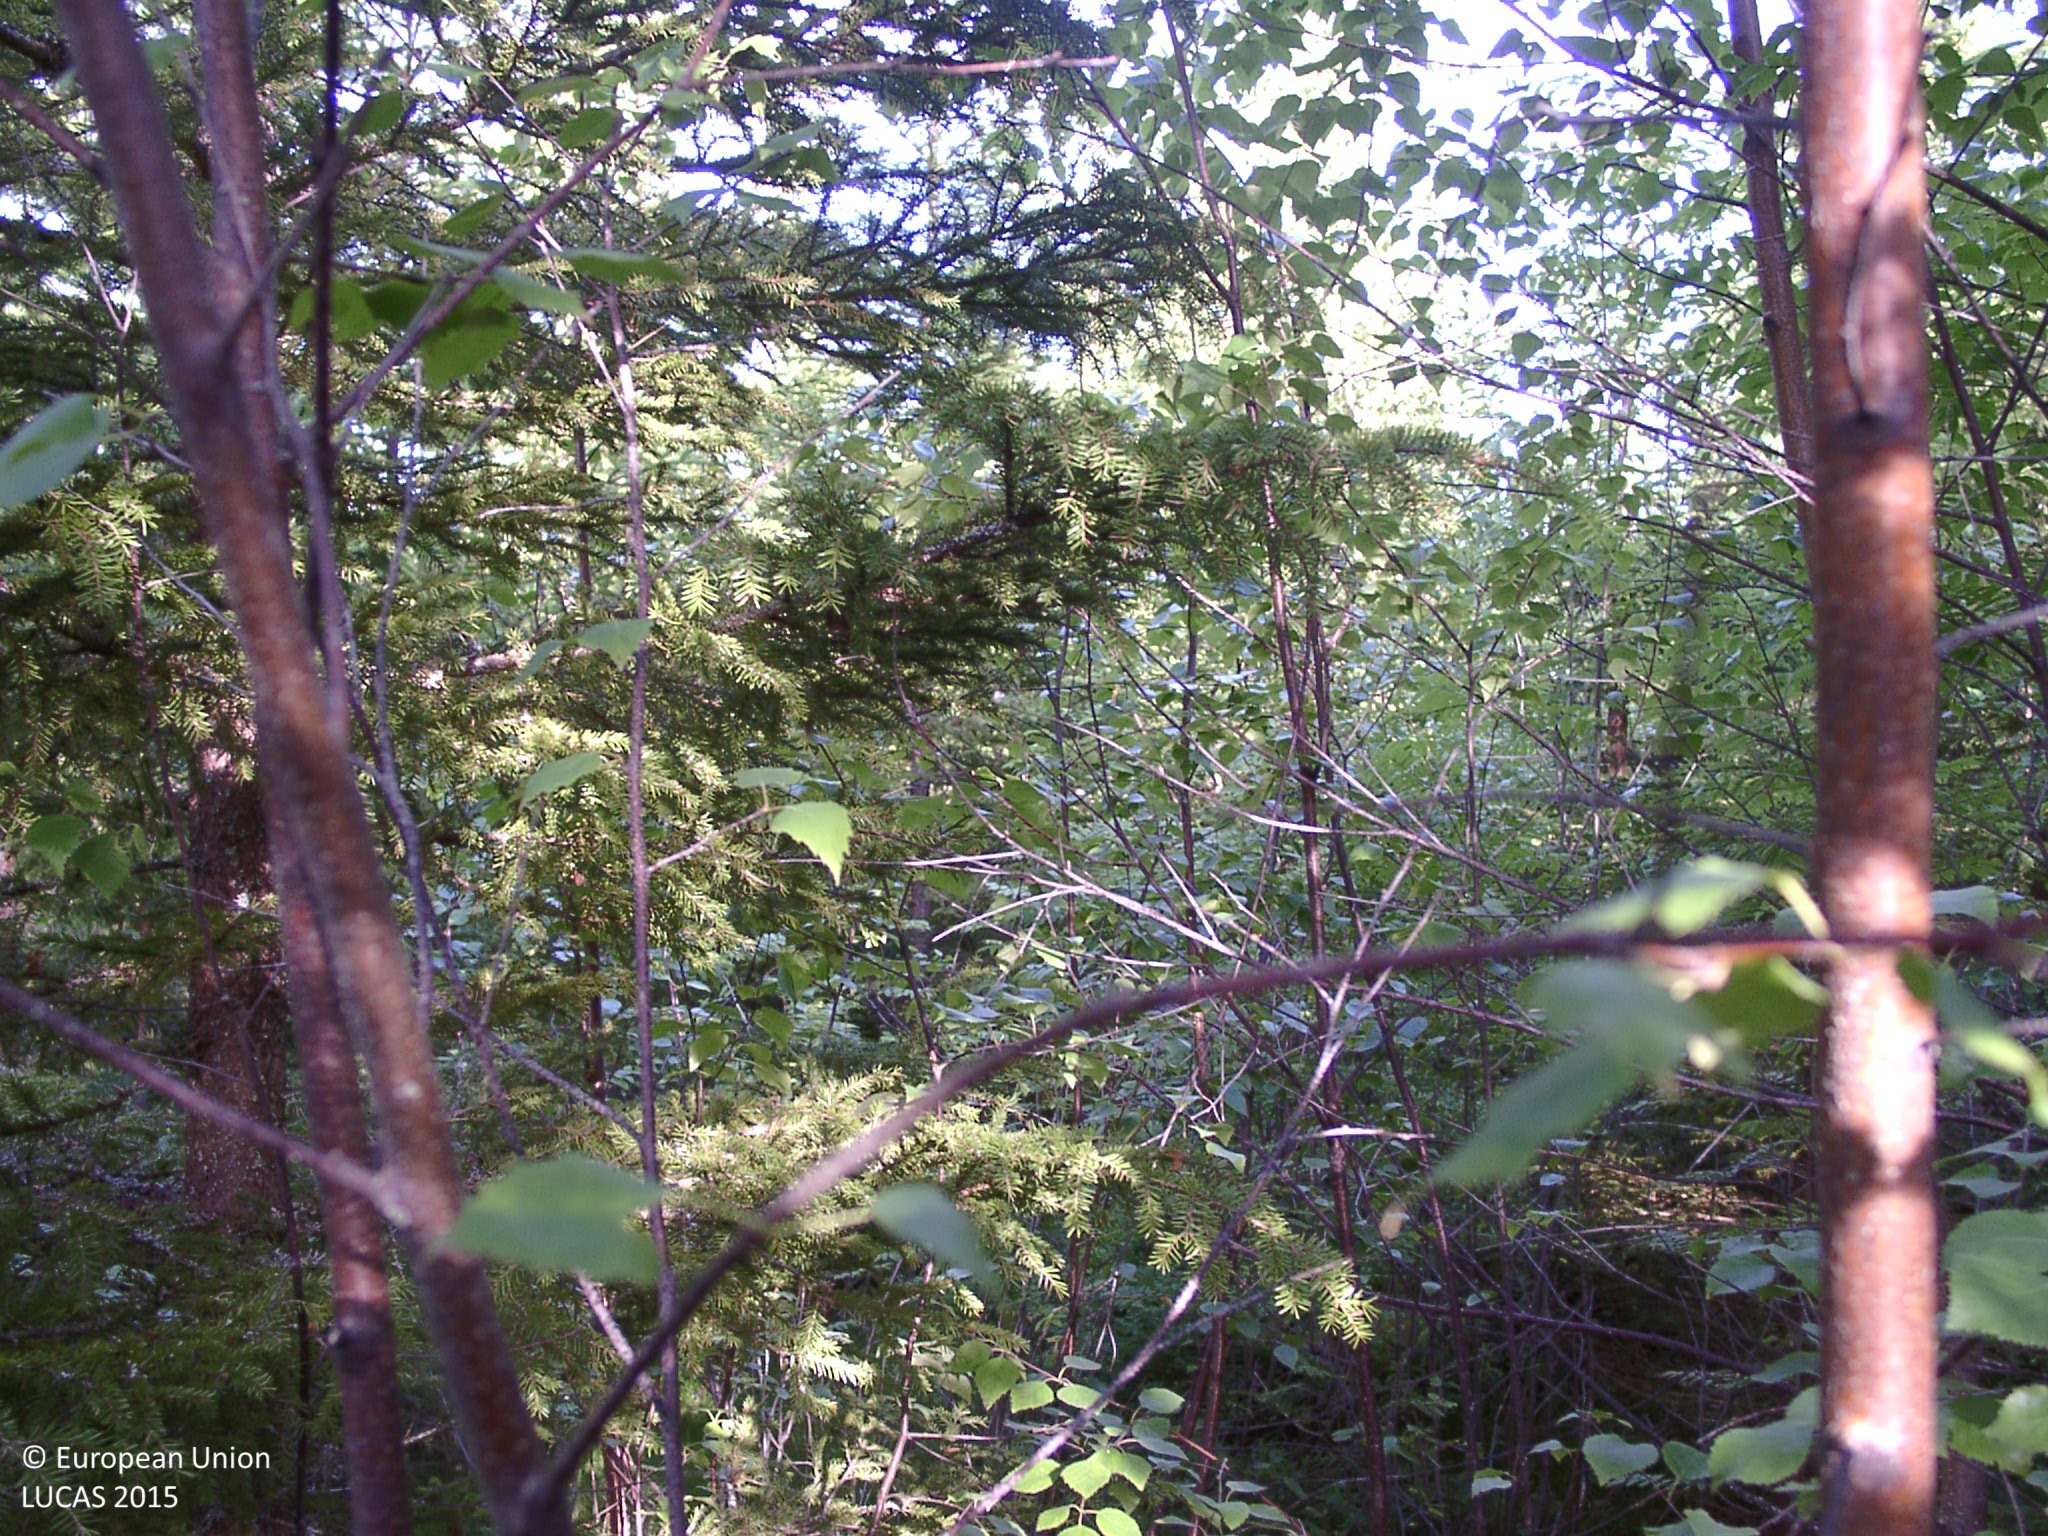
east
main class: Woodland
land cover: Spruce dominated mixed woodland
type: boreal forest
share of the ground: > 75 %
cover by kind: broadleaved forest trees 45 %, coniferous forest trees 40 %, shrubs 5 %, herbaceous plants 5 %, lichens and mosses 5 %
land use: Forestry
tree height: < 5 m
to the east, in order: Spruce dominated mixed woodland; Ditches and canals; Spruce dominated mixed woodland; Ditches and canals; Spruce dominated mixed woodland; Rivers and streams; Spruce dominated mixed woodland
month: July
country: FI
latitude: 62.2456
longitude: 25.1392
